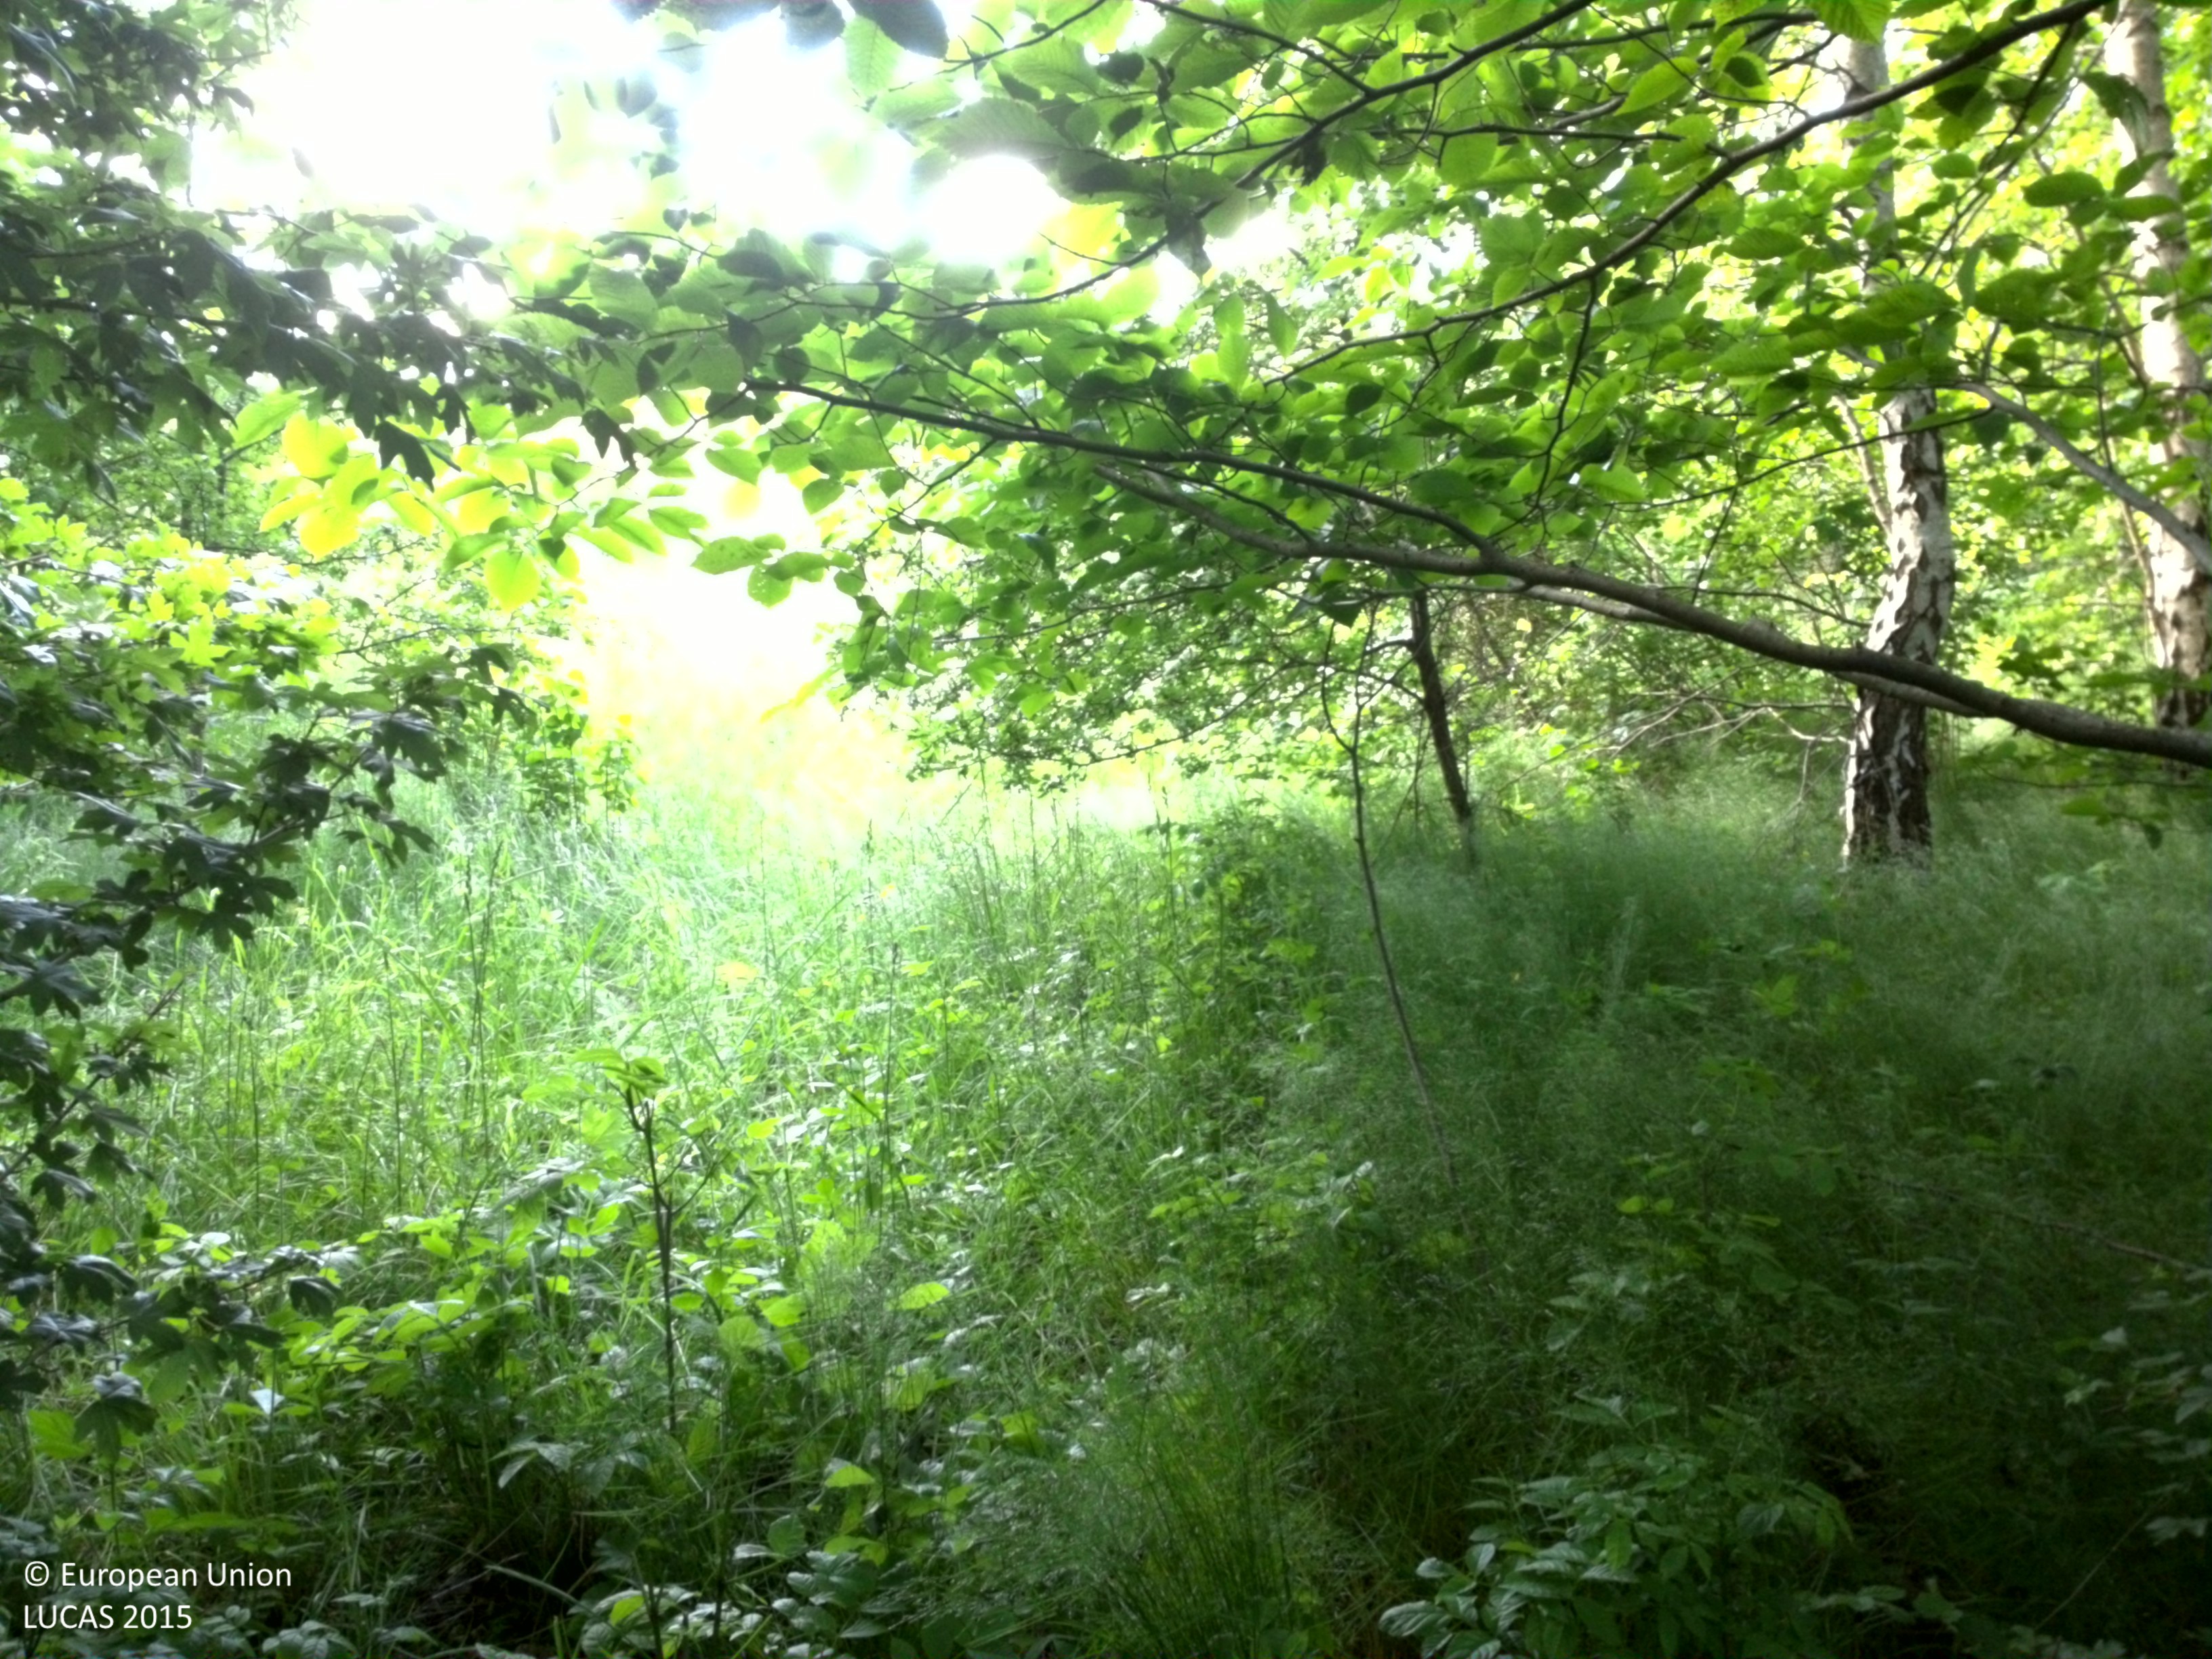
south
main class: Woodland
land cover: Broadleaved woodland
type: hemiboreal forest and nemoral coniferous forest and mixed broadleaved-coniferous forest
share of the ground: > 75 %
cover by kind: broadleaved forest trees 85 %, herbaceous plants 10 %, consolidated bare surface 5 %
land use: Amenities, museums, leisure
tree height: > 5 m
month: June
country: SE
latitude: 58.6369
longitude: 16.1791
